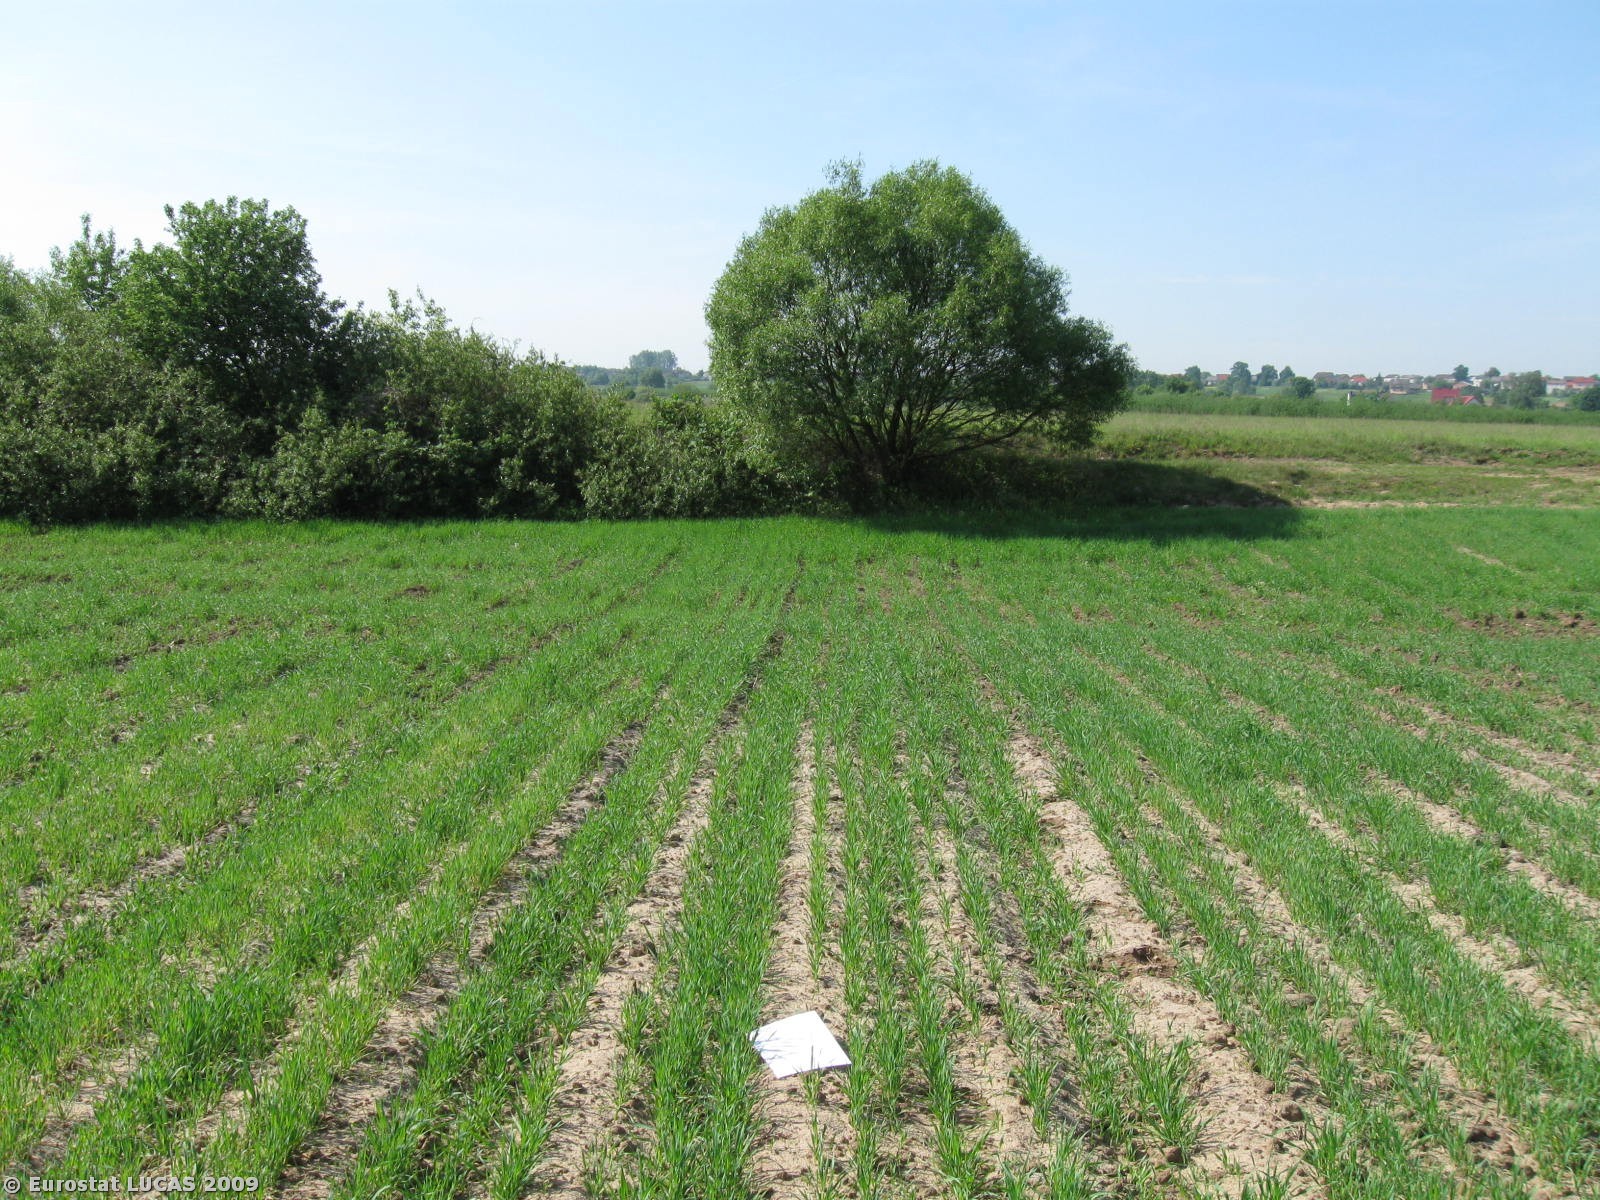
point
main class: Cropland
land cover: Barley
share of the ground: 50 - 75 %
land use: Agriculture (excluding fallow land and kitchen gardens)
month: May
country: PL
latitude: 50.7717
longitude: 20.4601
